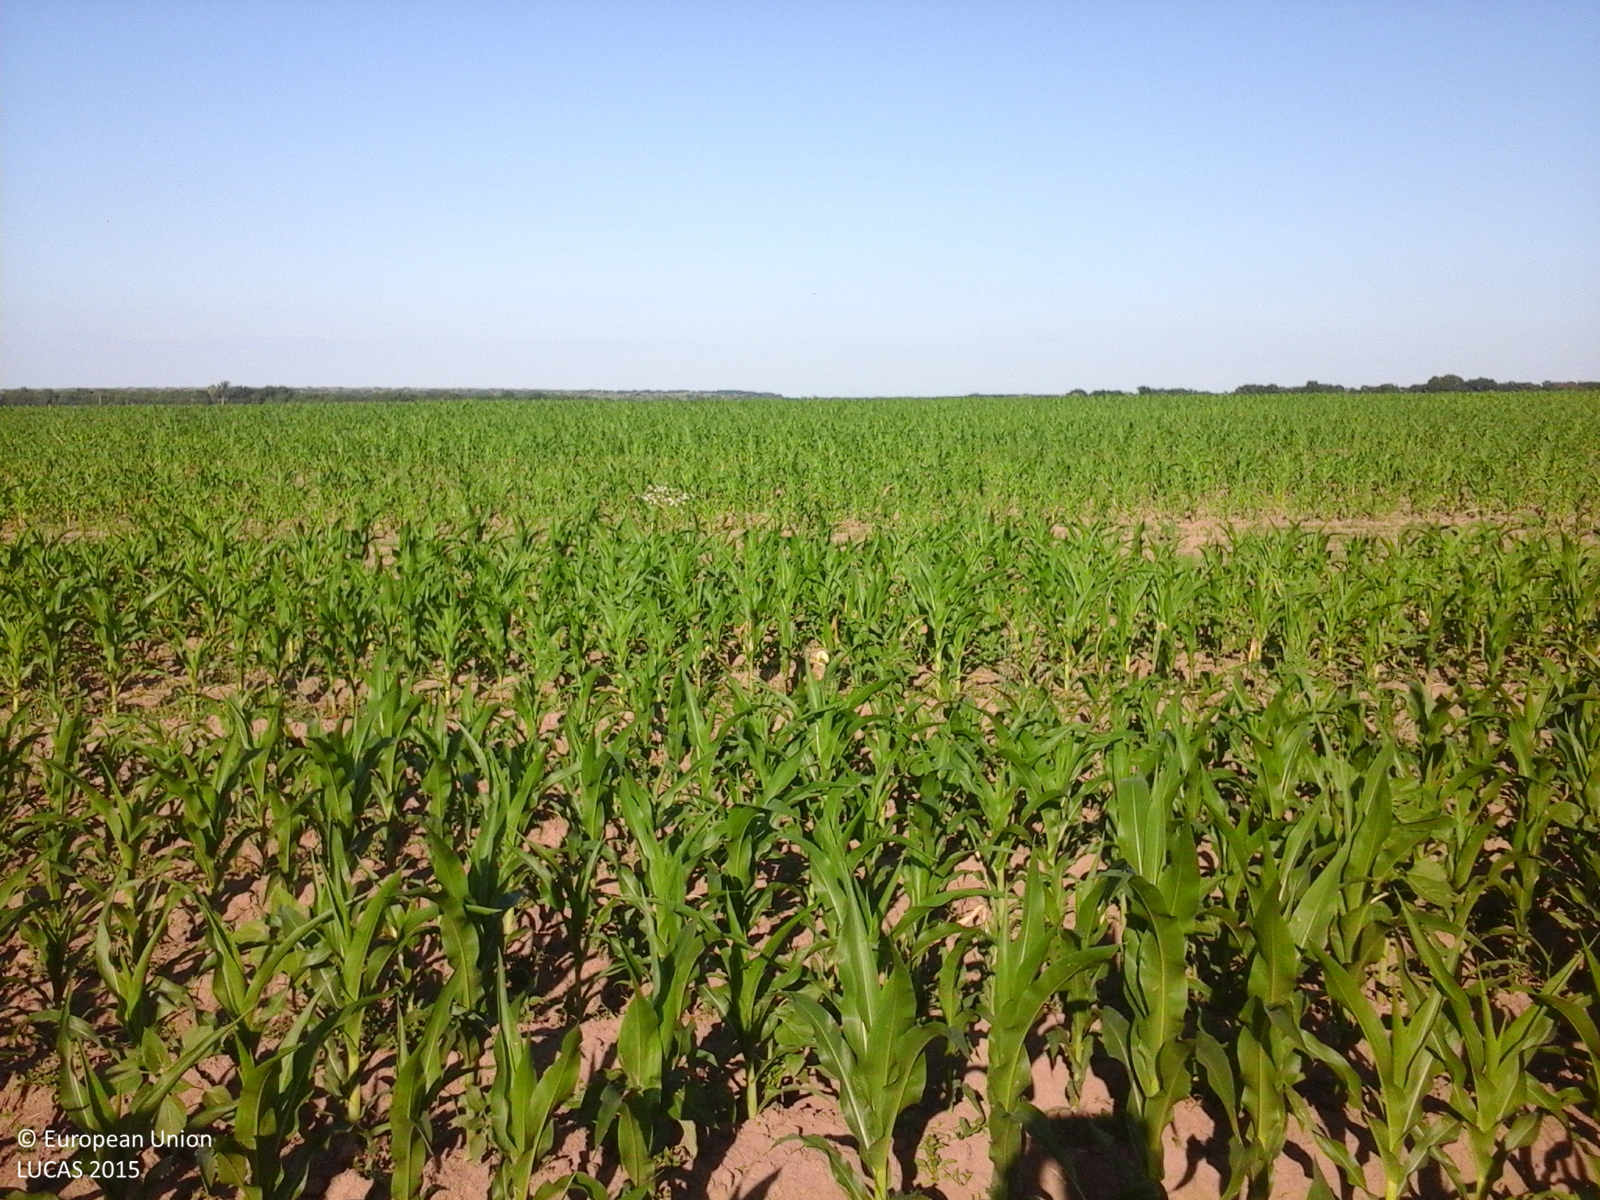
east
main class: Cropland
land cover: Maize
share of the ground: 50 - 75 %
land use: Agriculture (excluding fallow land and kitchen gardens)
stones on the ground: < 10 %
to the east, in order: Maize
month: June
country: RO
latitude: 47.1162
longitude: 27.3091
